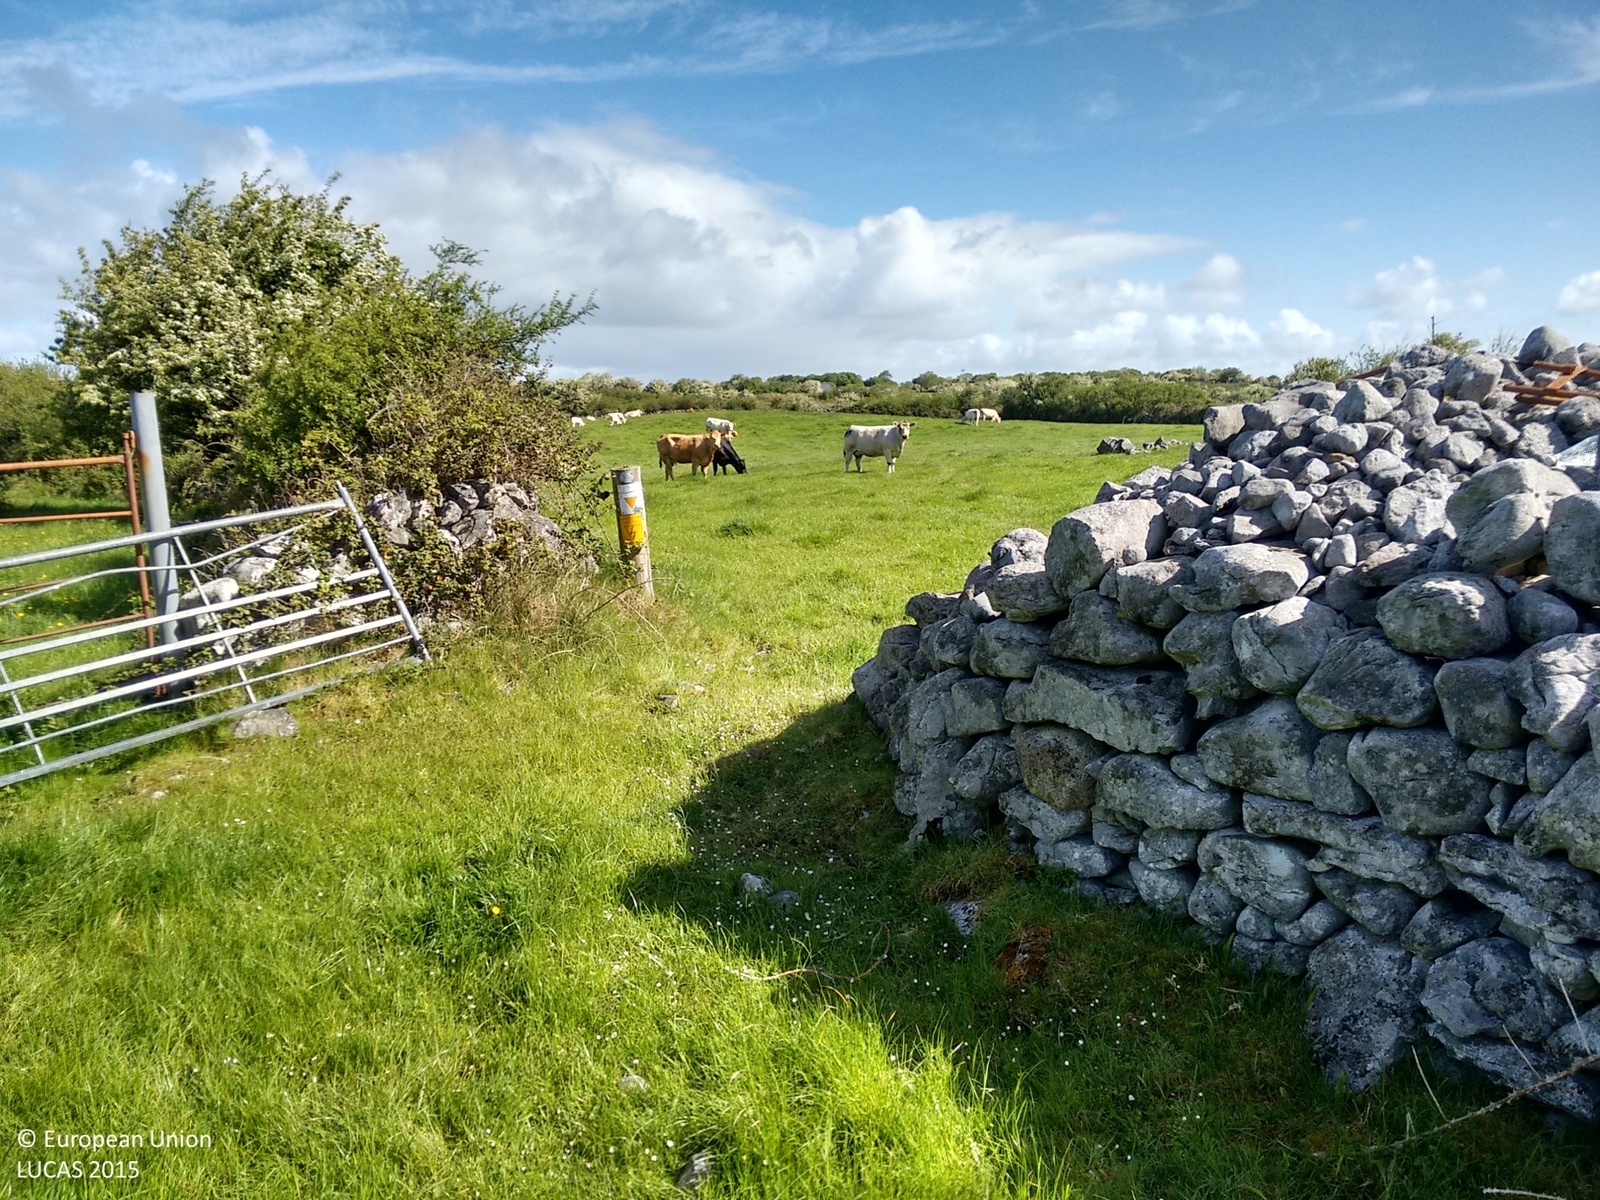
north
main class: Grassland
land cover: Grassland without tree/shrub cover
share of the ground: > 75 %
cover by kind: herbaceous plants 100 %
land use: Agriculture (excluding fallow land and kitchen gardens)
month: May
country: IE
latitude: 53.1487
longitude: -8.9144
